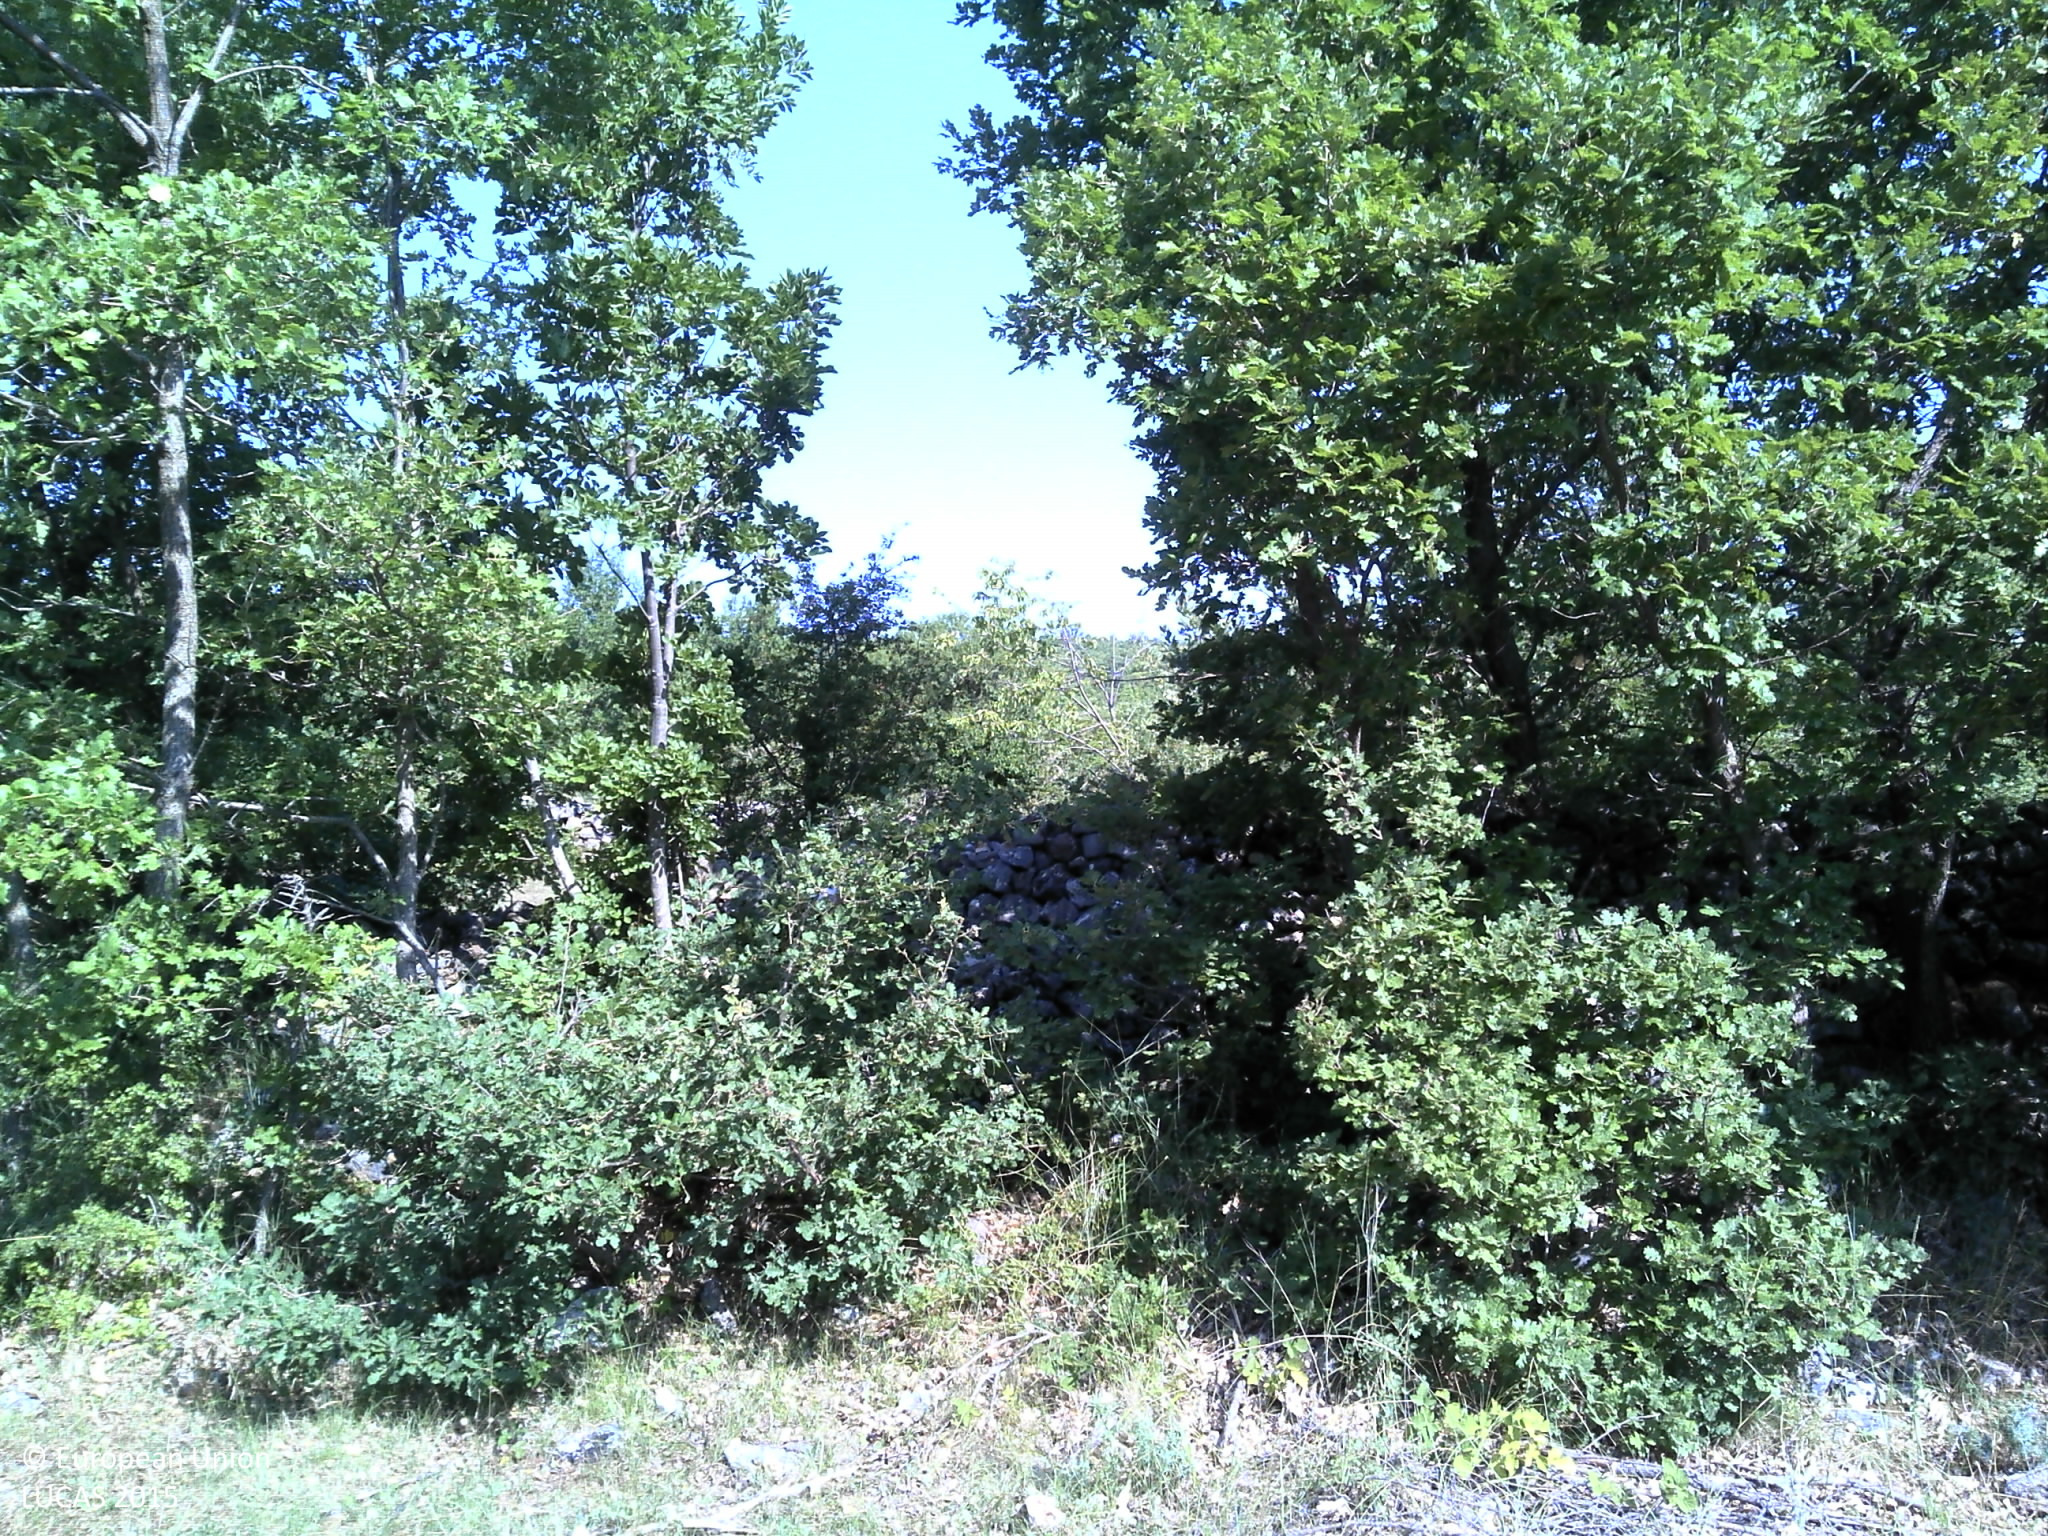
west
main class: Woodland
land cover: Broadleaved woodland
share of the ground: 25 - 50 %
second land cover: Grassland without tree/shrub cover
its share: 50 - 75 %
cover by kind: herbaceous plants 50 %, broadleaved forest trees 30 %, shrubs 20 %
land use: Forestry
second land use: Agriculture (excluding fallow land and kitchen gardens)
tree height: > 5 m
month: July
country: HR
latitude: 43.9789
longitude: 16.2880
